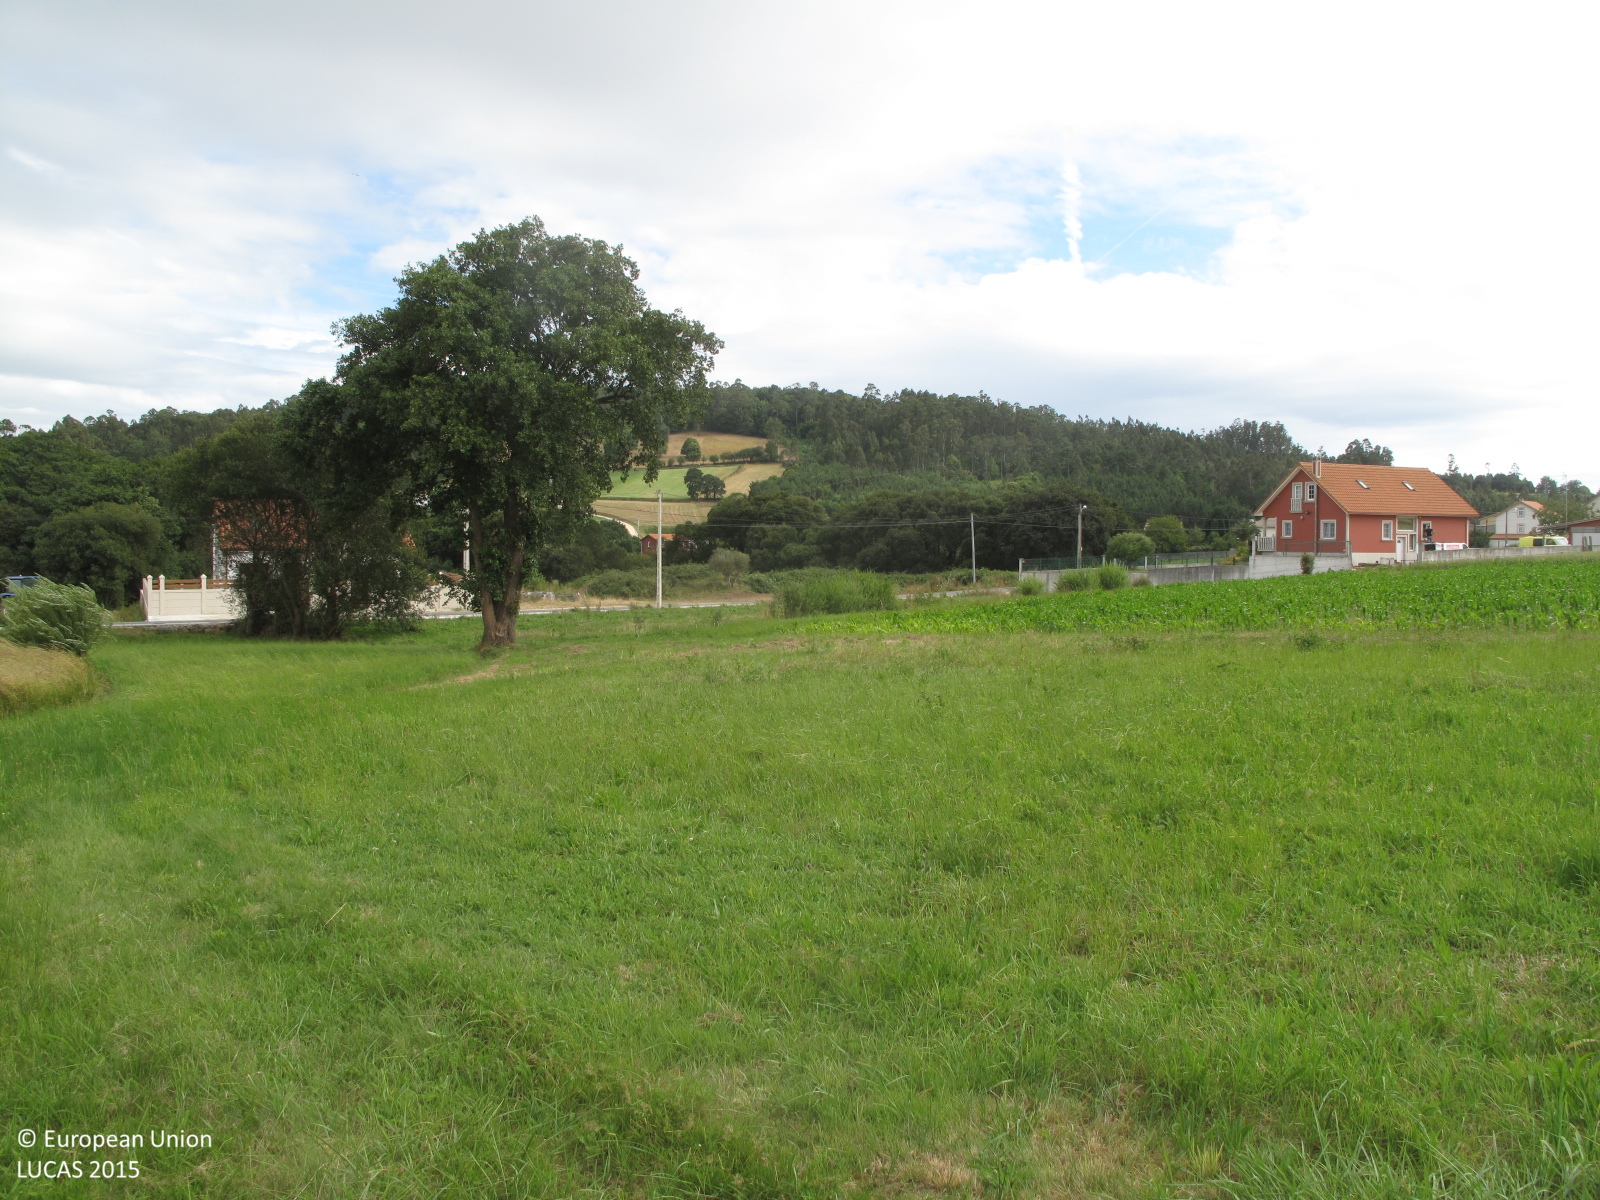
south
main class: Grassland
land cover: Grassland without tree/shrub cover
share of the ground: > 75 %
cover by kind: herbaceous plants 100 %
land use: Agriculture (excluding fallow land and kitchen gardens)
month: July
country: ES
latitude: 43.2423
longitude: -8.5964
